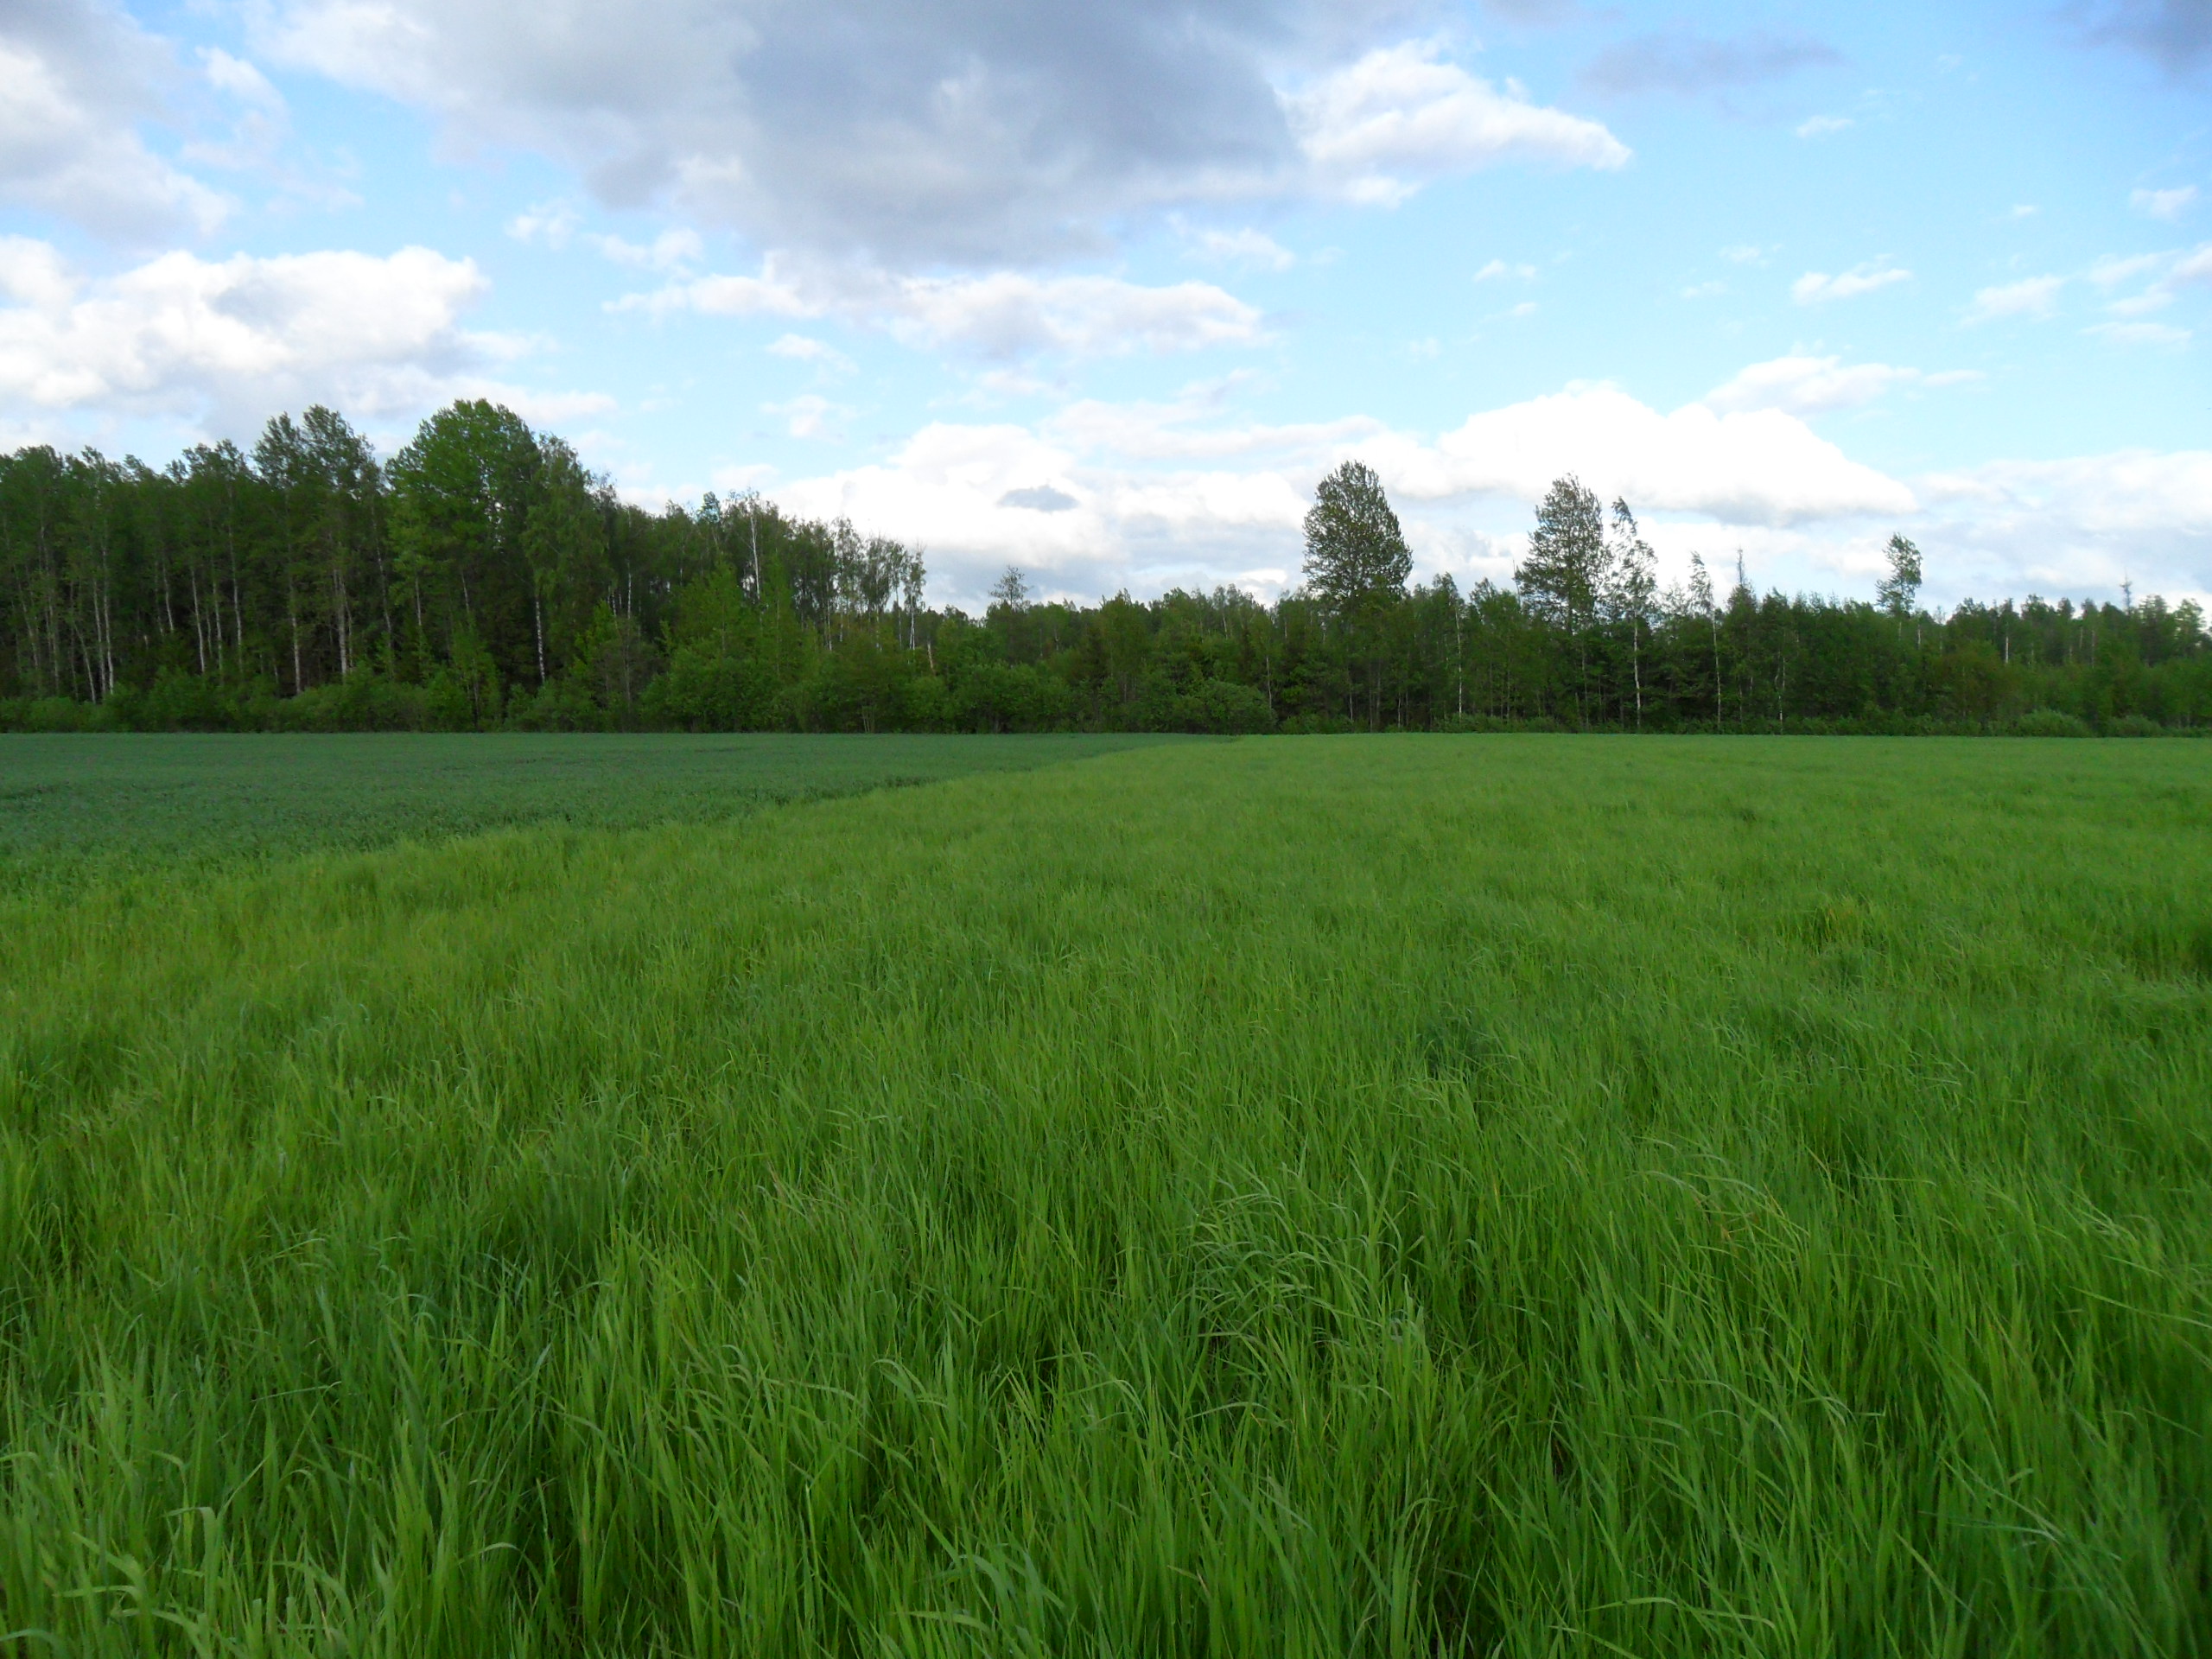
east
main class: Cropland
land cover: Temporary grasslands
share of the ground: > 75 %
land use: Agriculture (excluding fallow land and kitchen gardens)
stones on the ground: < 10 %
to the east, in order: Temporary grasslands; Common wheat; Grass margins; Ditches and canals; Broadleaved woodland; Spruce dominated mixed woodland
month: June
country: LV
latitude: 57.3300
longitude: 22.4269
